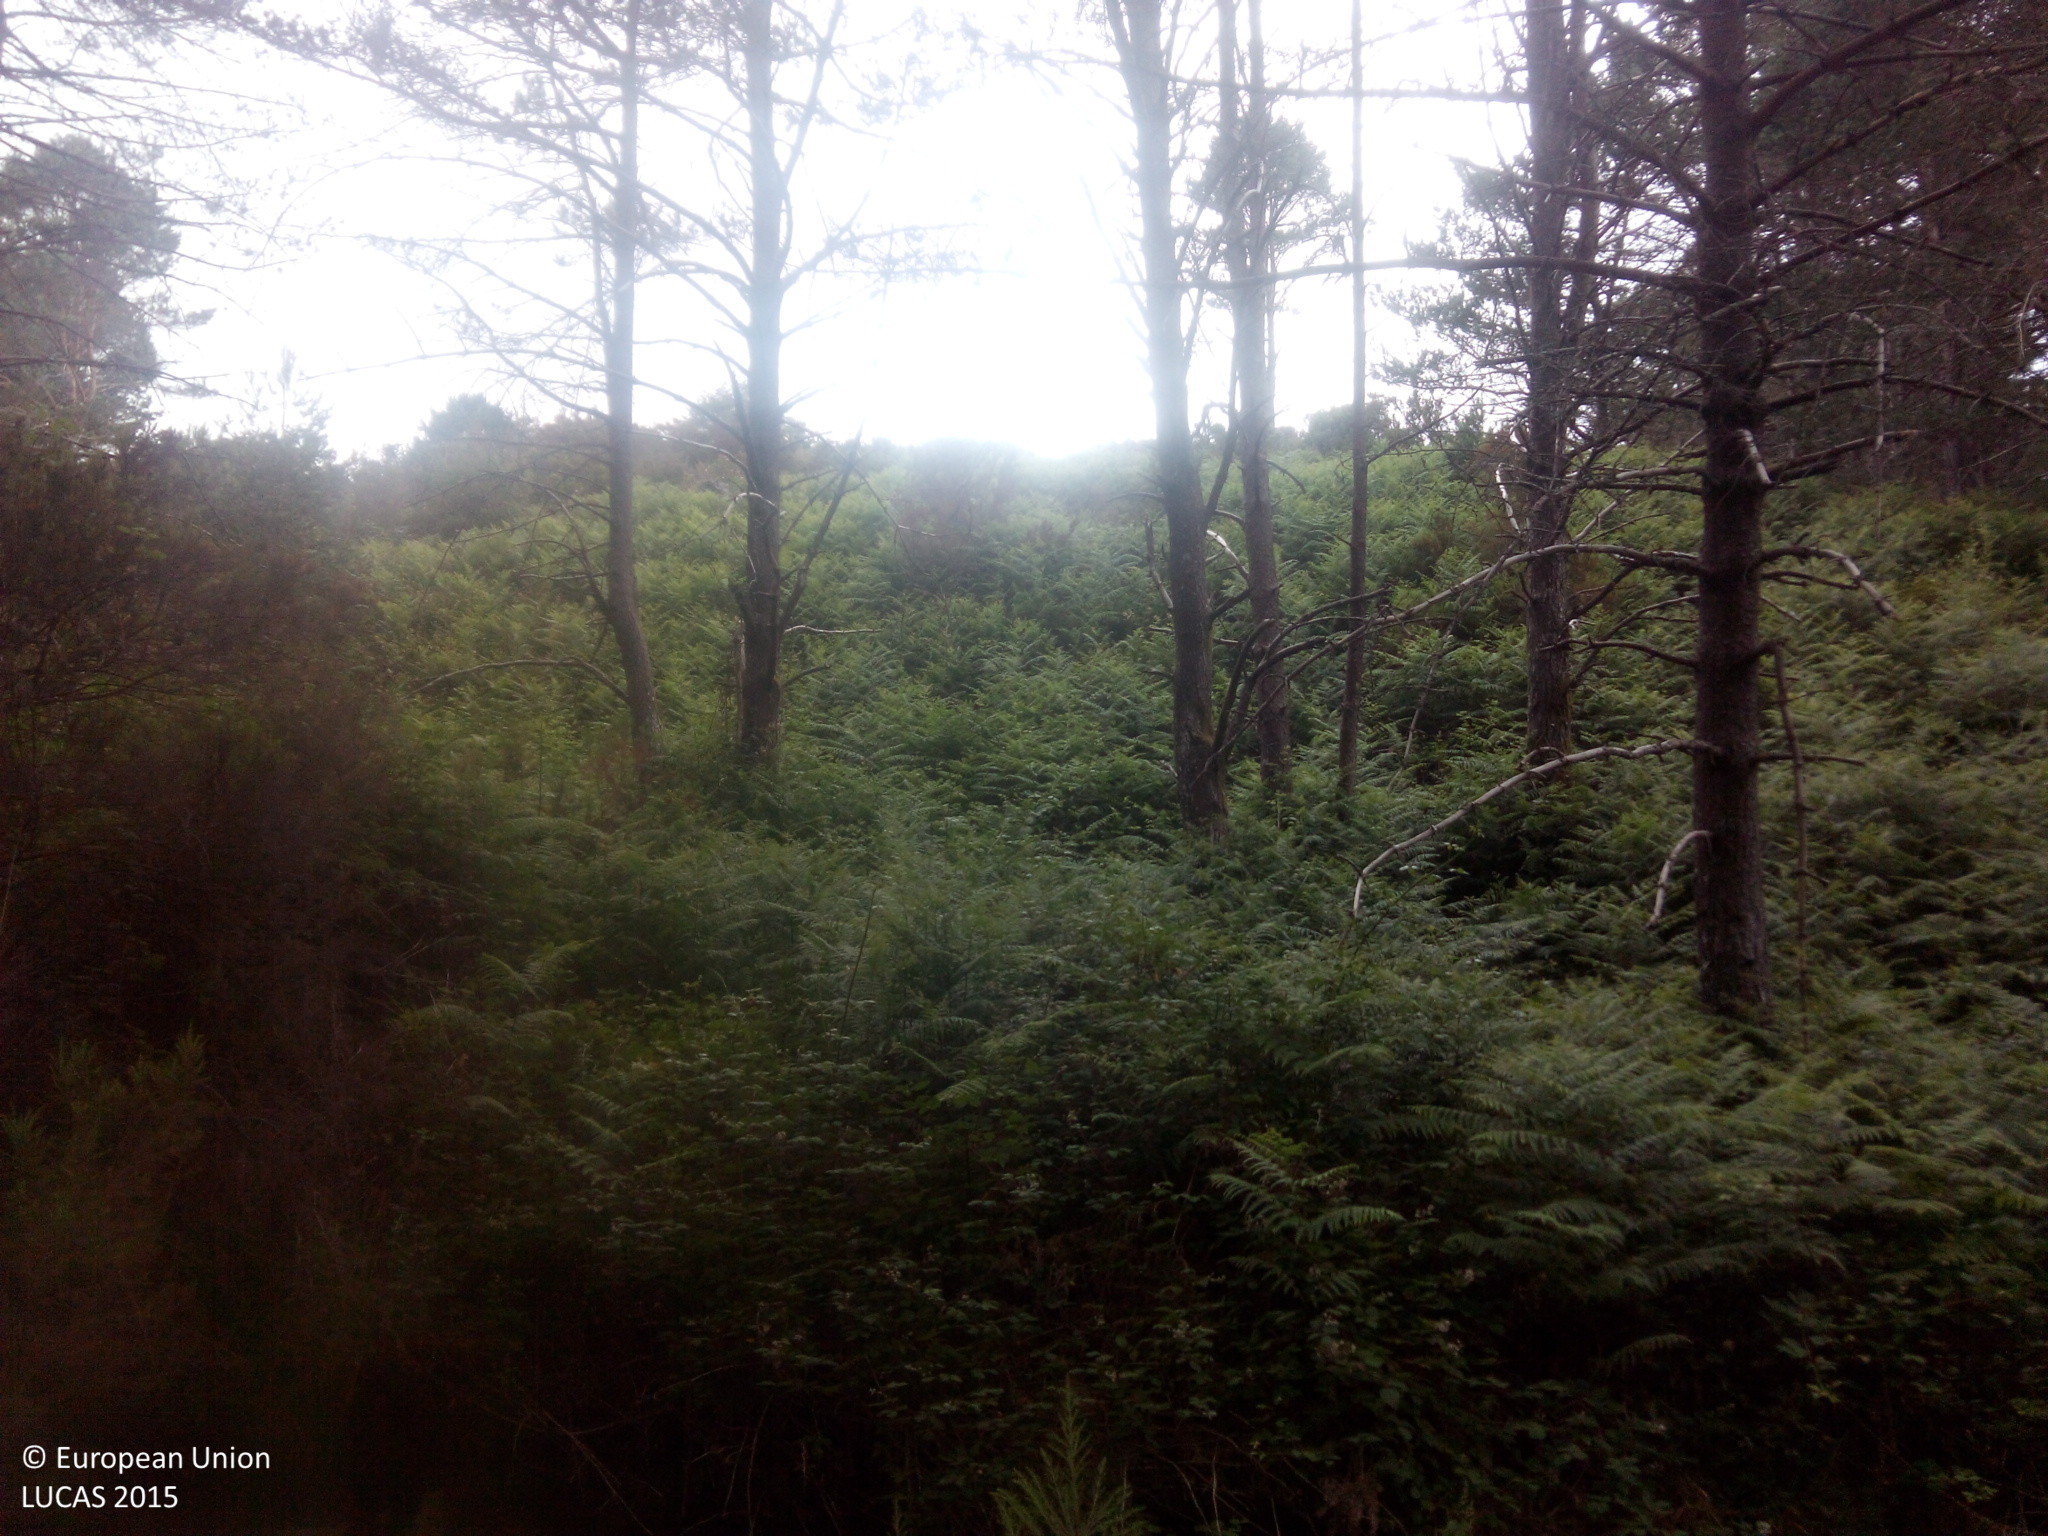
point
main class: Woodland
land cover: Pine dominated coniferous woodland
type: exotic forest
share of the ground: > 75 %
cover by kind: coniferous forest trees 100 %
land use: Forestry
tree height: > 5 m
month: July
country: ES
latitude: 42.3091
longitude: -8.2490
